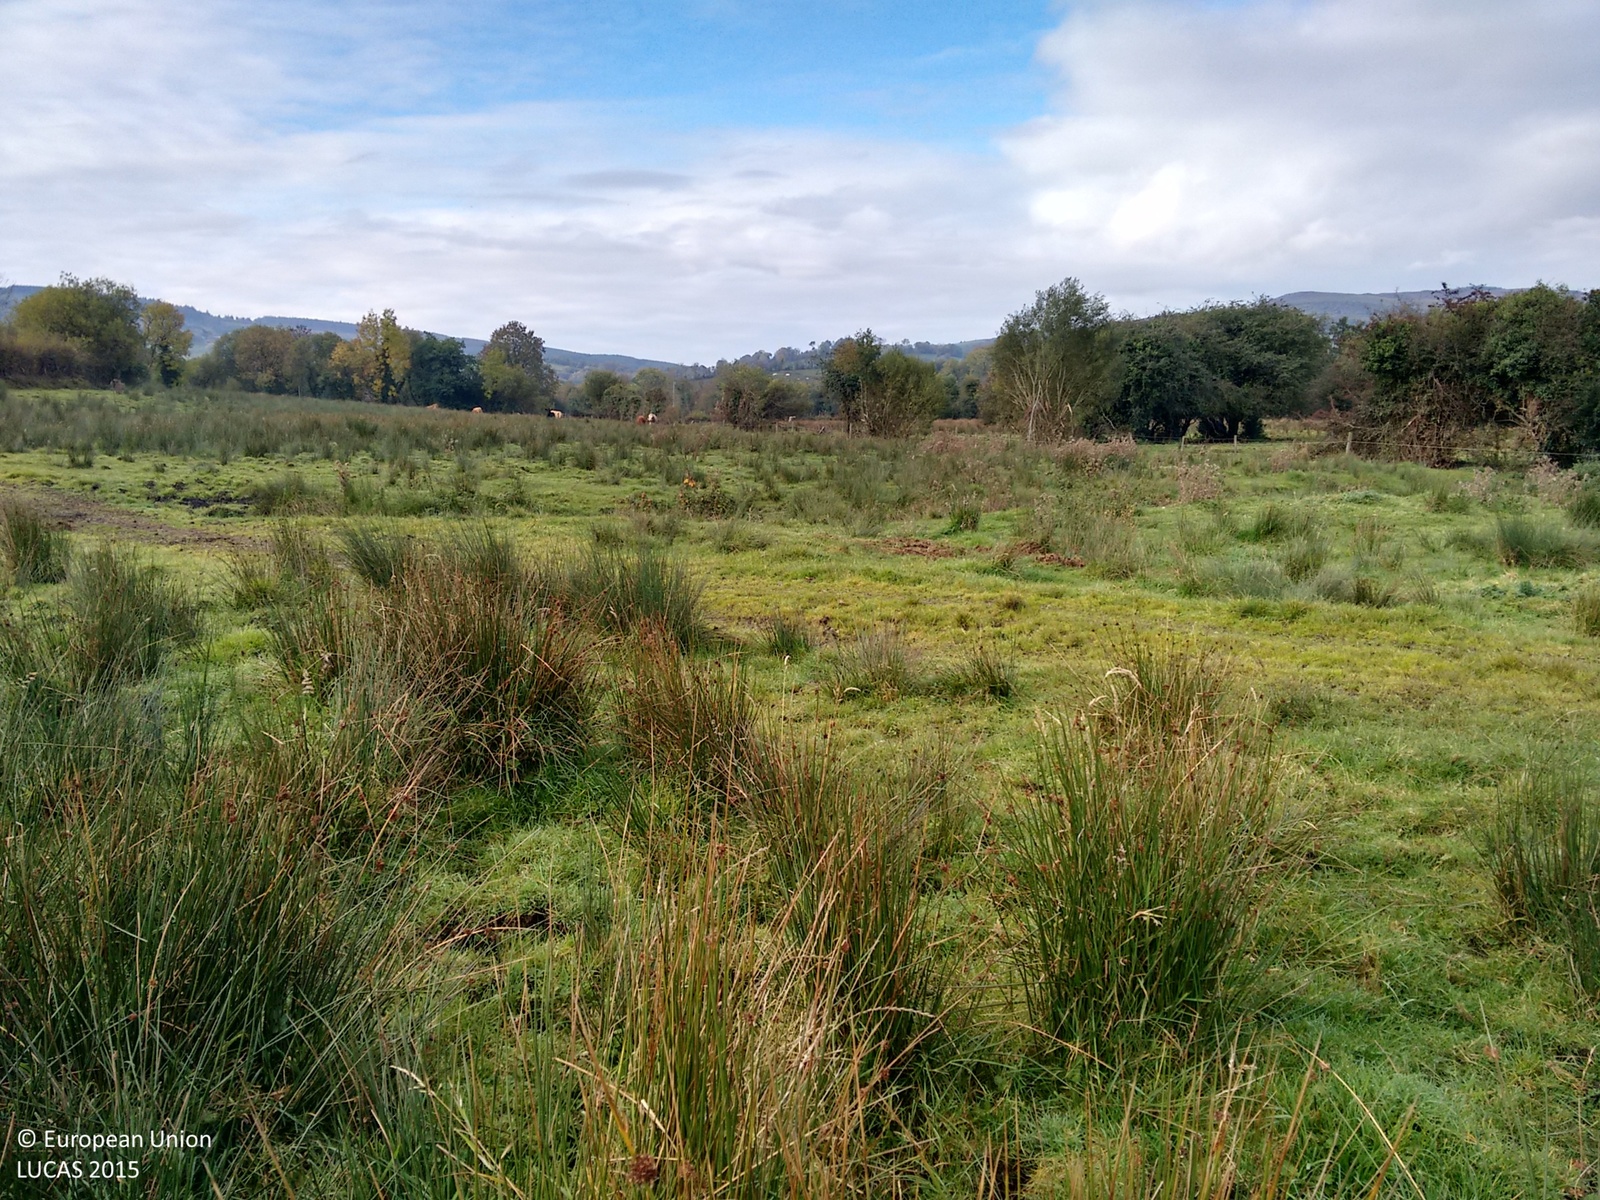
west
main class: Grassland
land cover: Grassland without tree/shrub cover
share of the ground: > 75 %
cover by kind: herbaceous plants 100 %
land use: Agriculture (excluding fallow land and kitchen gardens)
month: October
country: GB
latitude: 54.3571
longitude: -7.7848
